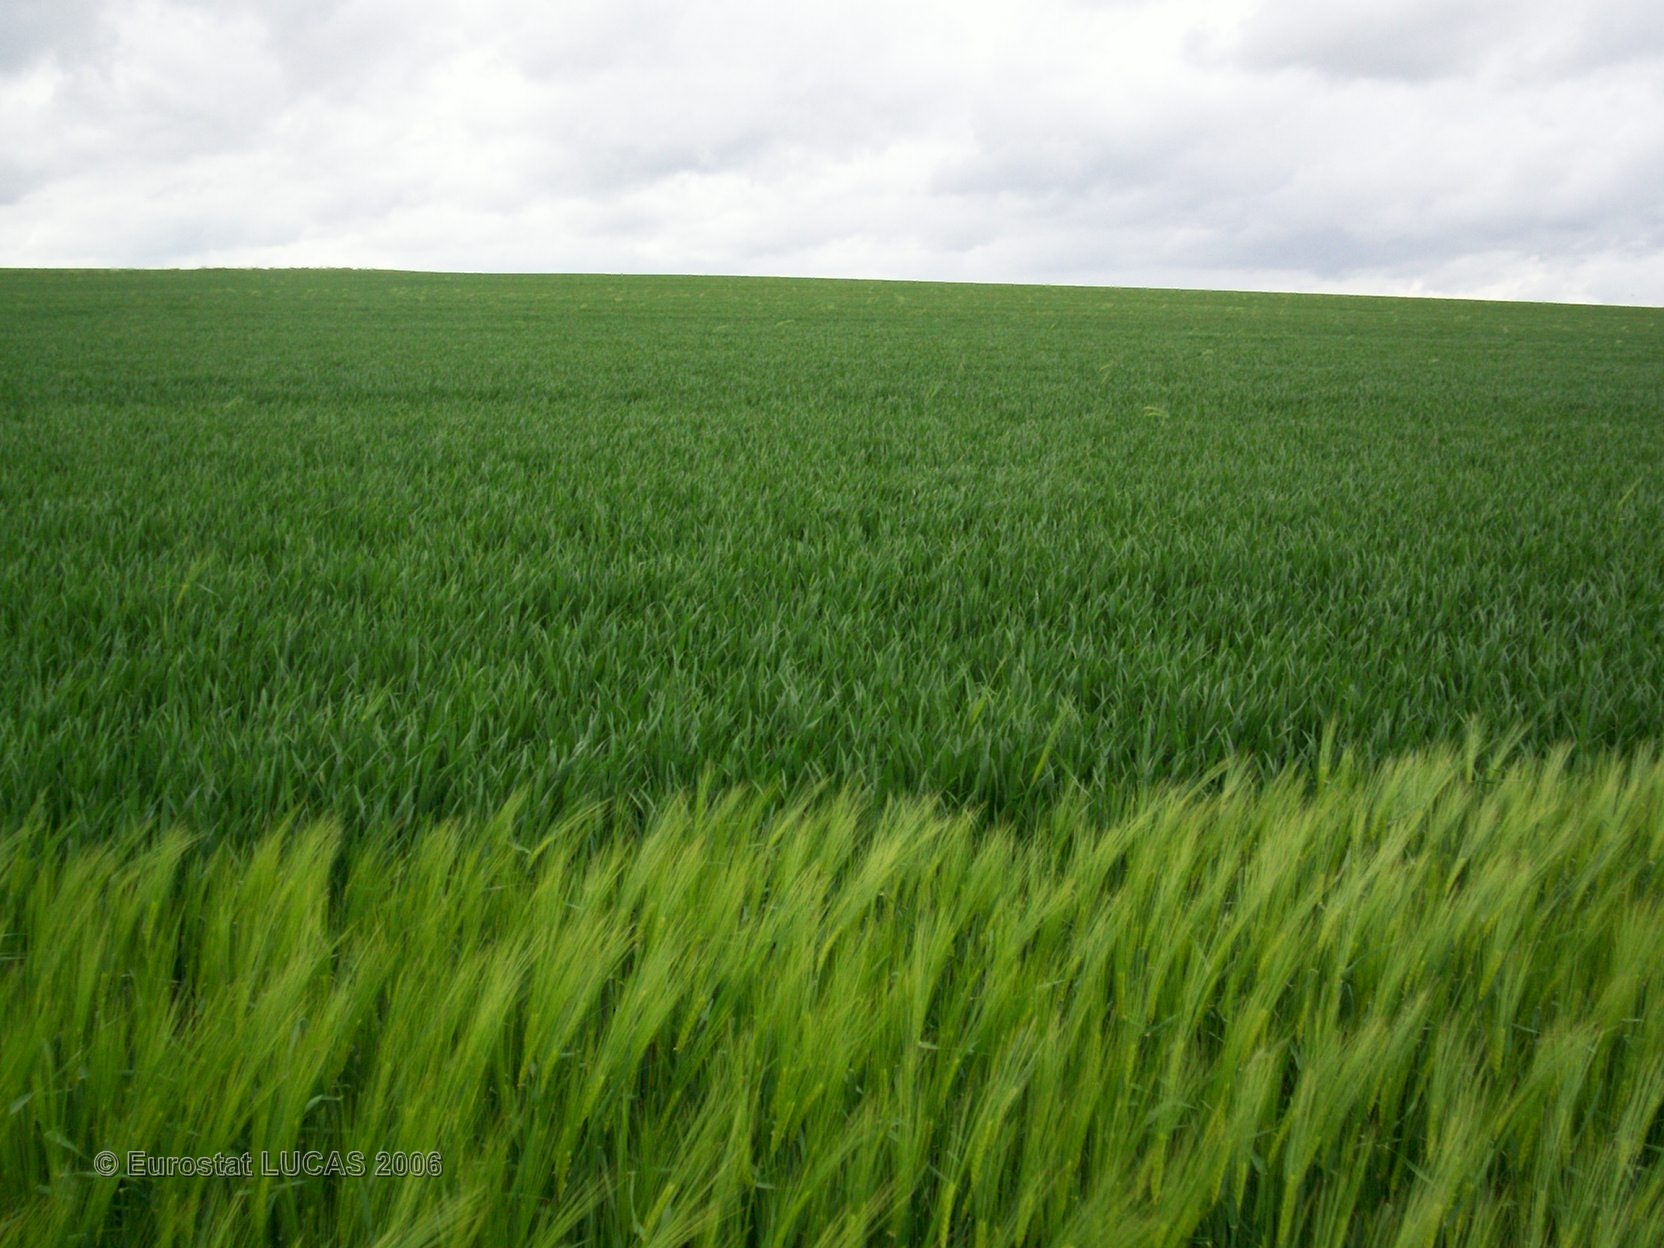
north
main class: Cropland
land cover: Barley
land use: Agriculture (excluding fallow land and kitchen gardens)
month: May
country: FR
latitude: 49.4244
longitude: 5.8493
